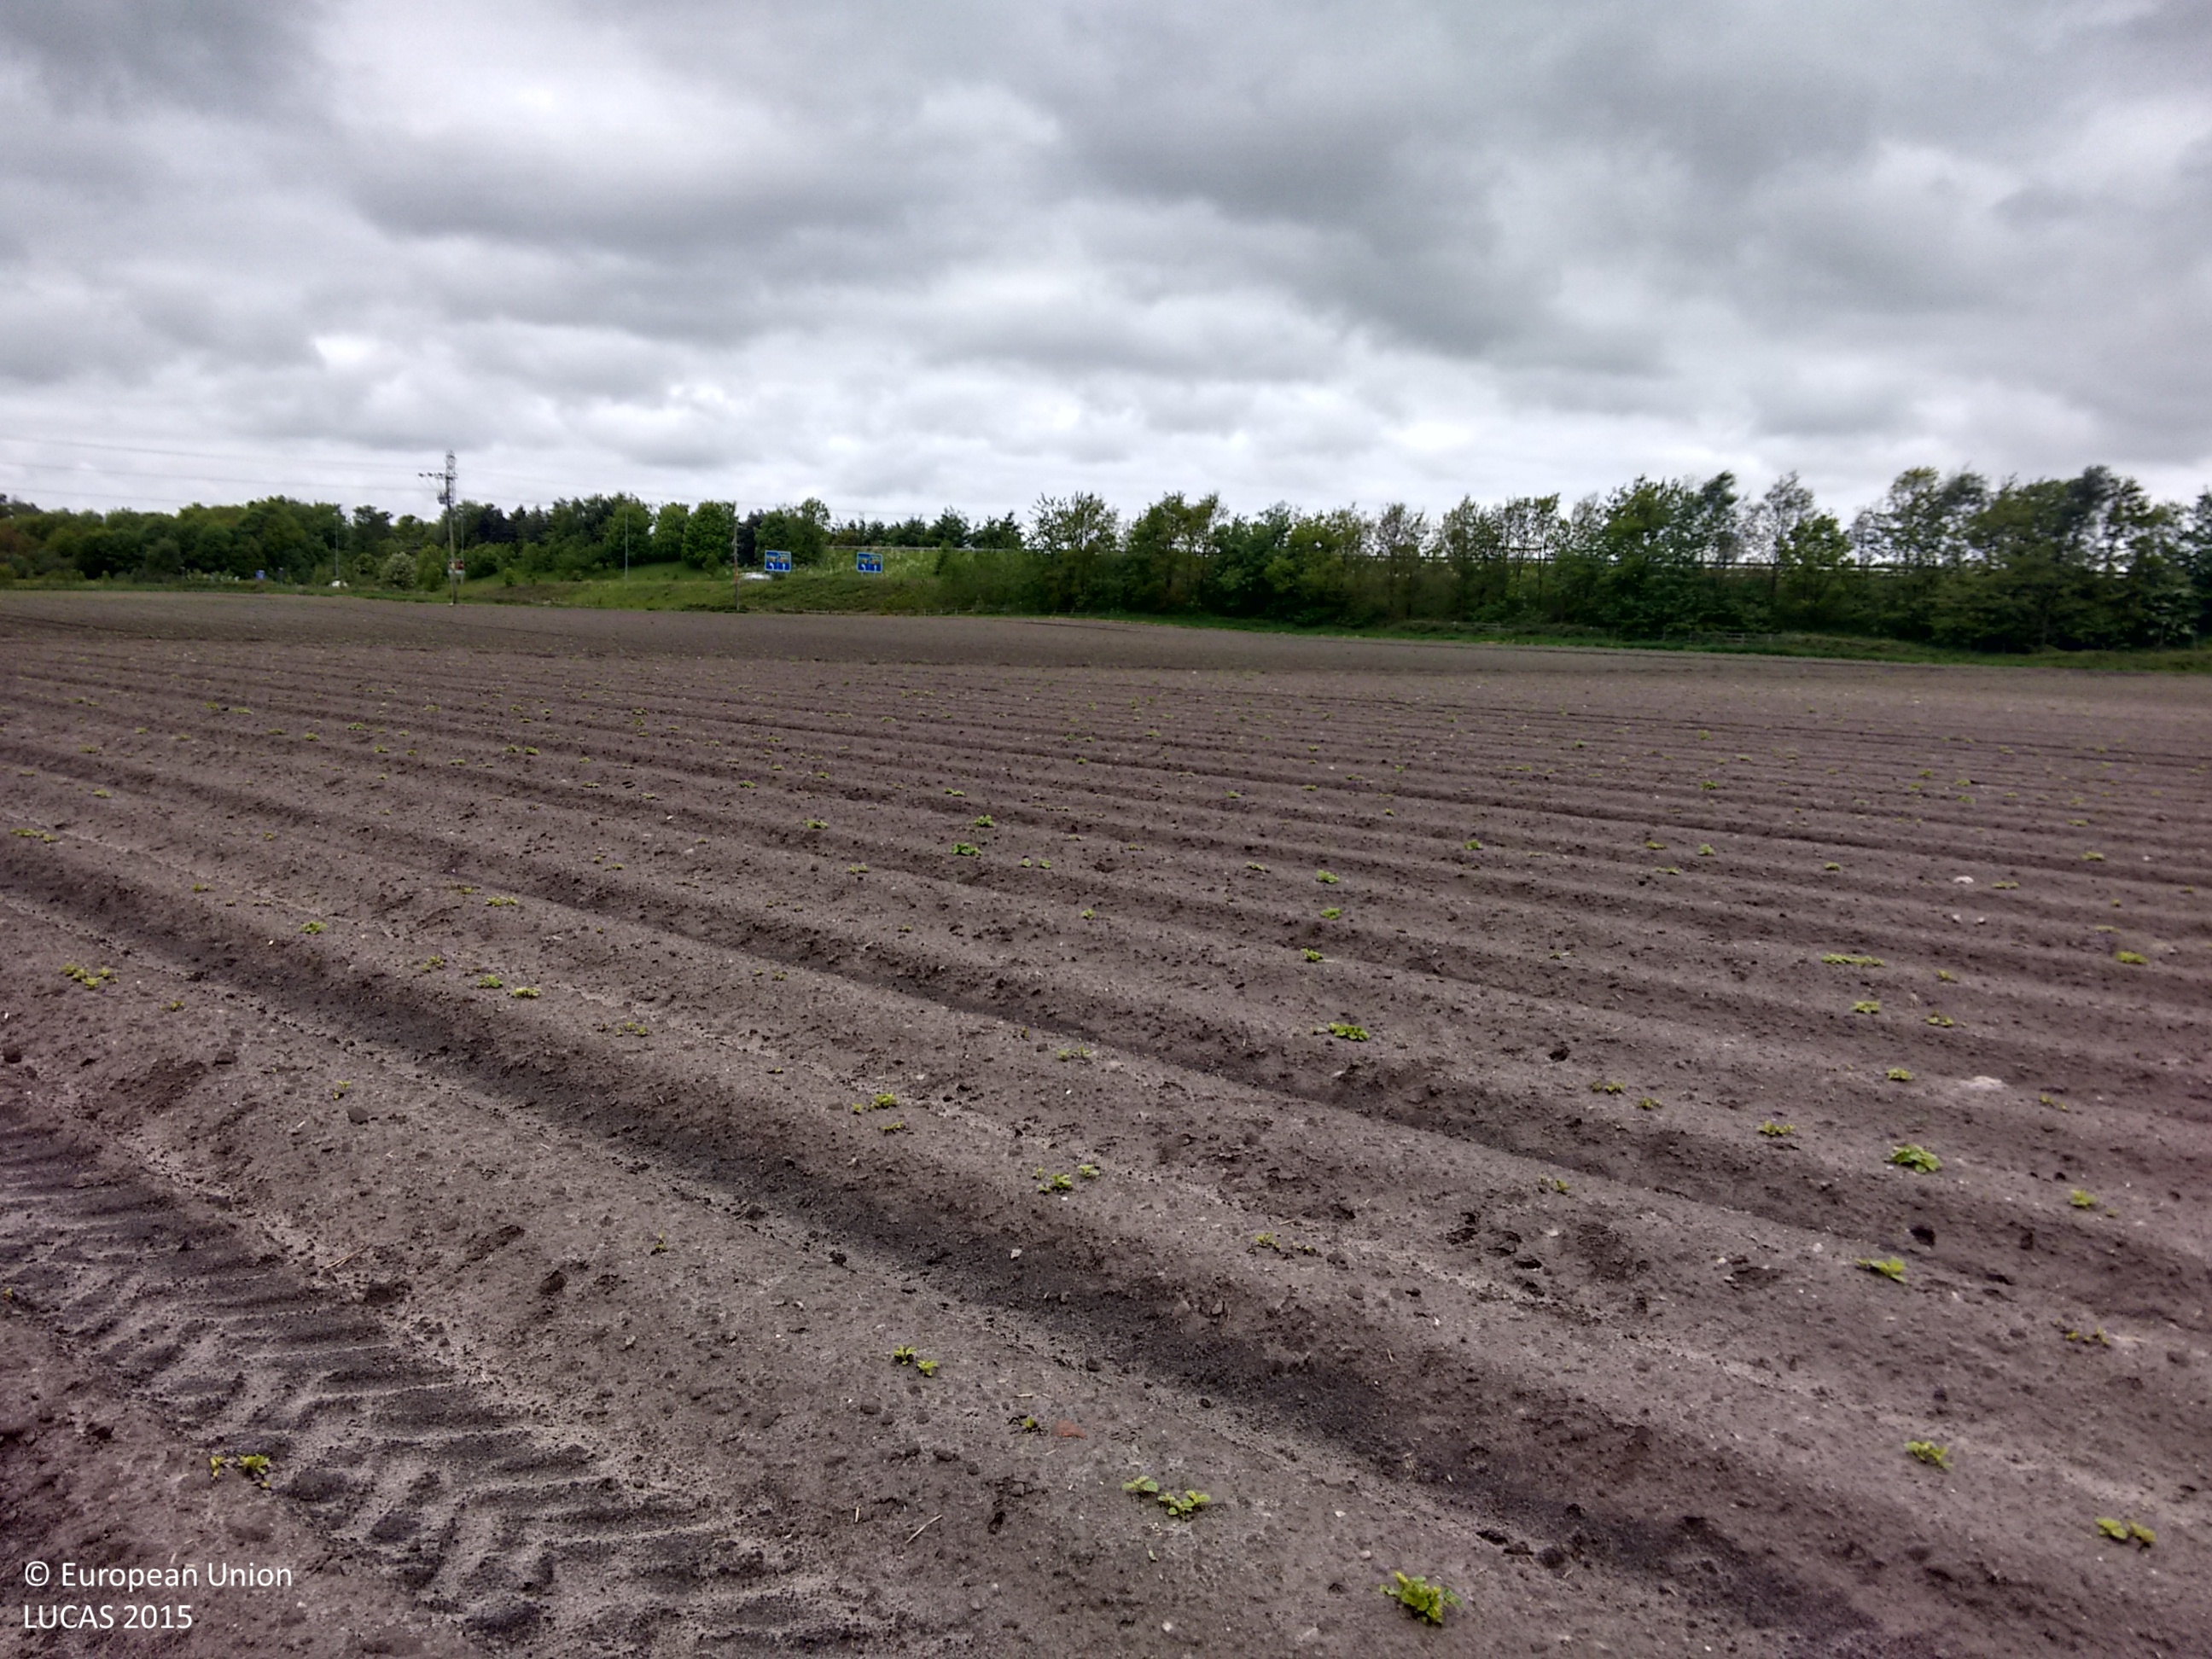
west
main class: Cropland
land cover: Potatoes
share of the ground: < 10 %
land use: Agriculture (excluding fallow land and kitchen gardens)
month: May
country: GB
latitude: 53.5366
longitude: -2.8207
